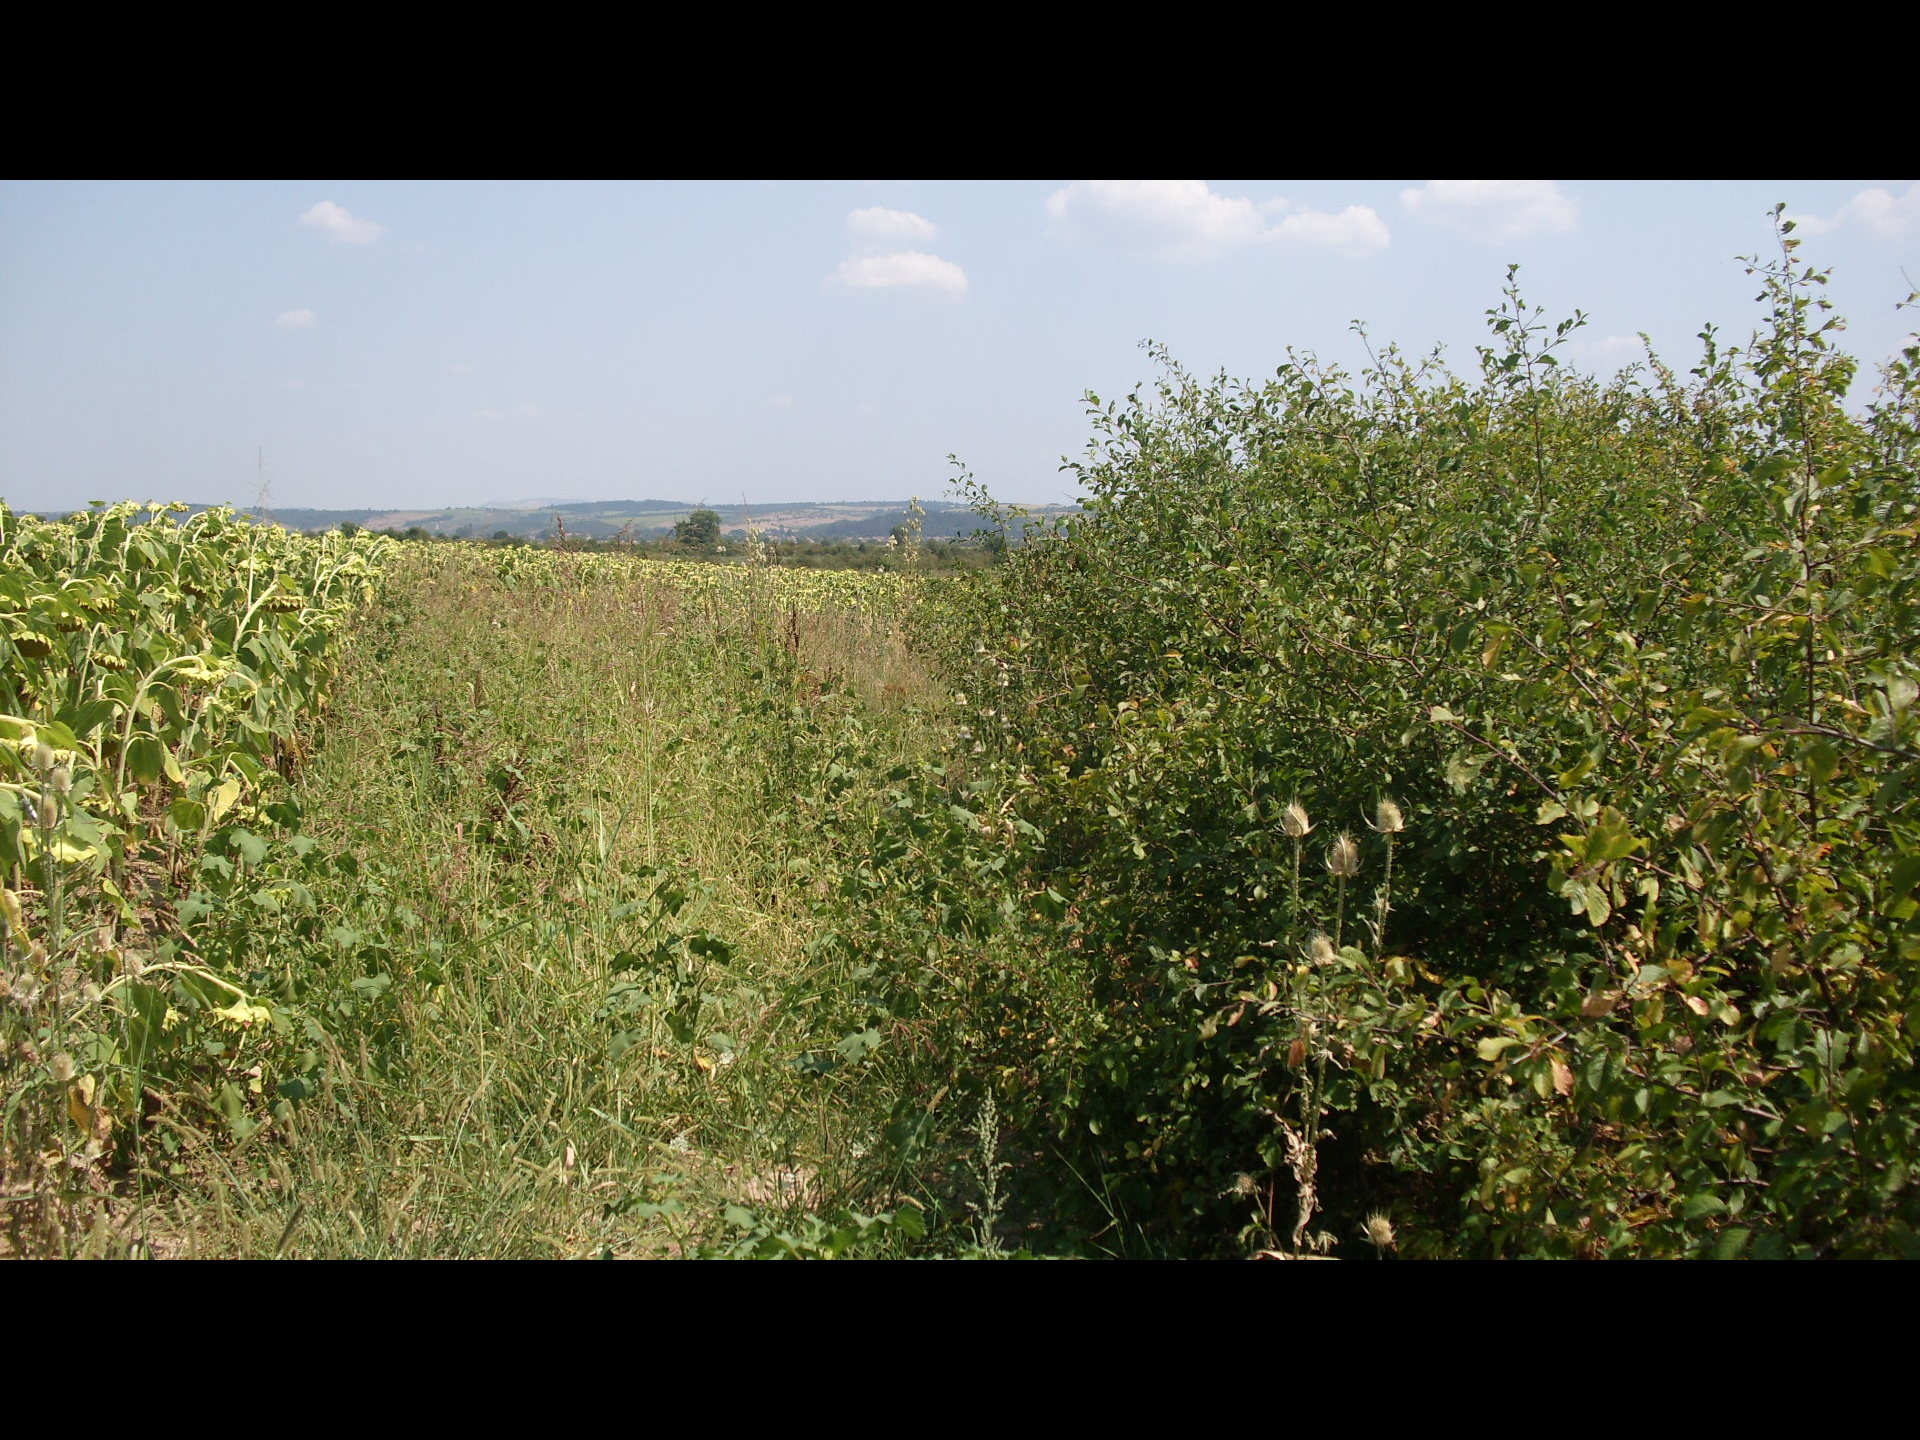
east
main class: Shrubland
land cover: Shrubland without tree cover
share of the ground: > 75 %
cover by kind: shrubs 95 %, herbaceous plants 5 %
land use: Agriculture (excluding fallow land and kitchen gardens)
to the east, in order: Shrubland without tree cover; Spontaneously vegetated surfaces; Sunflower
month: August
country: BG
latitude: 43.2988
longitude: 23.3658
